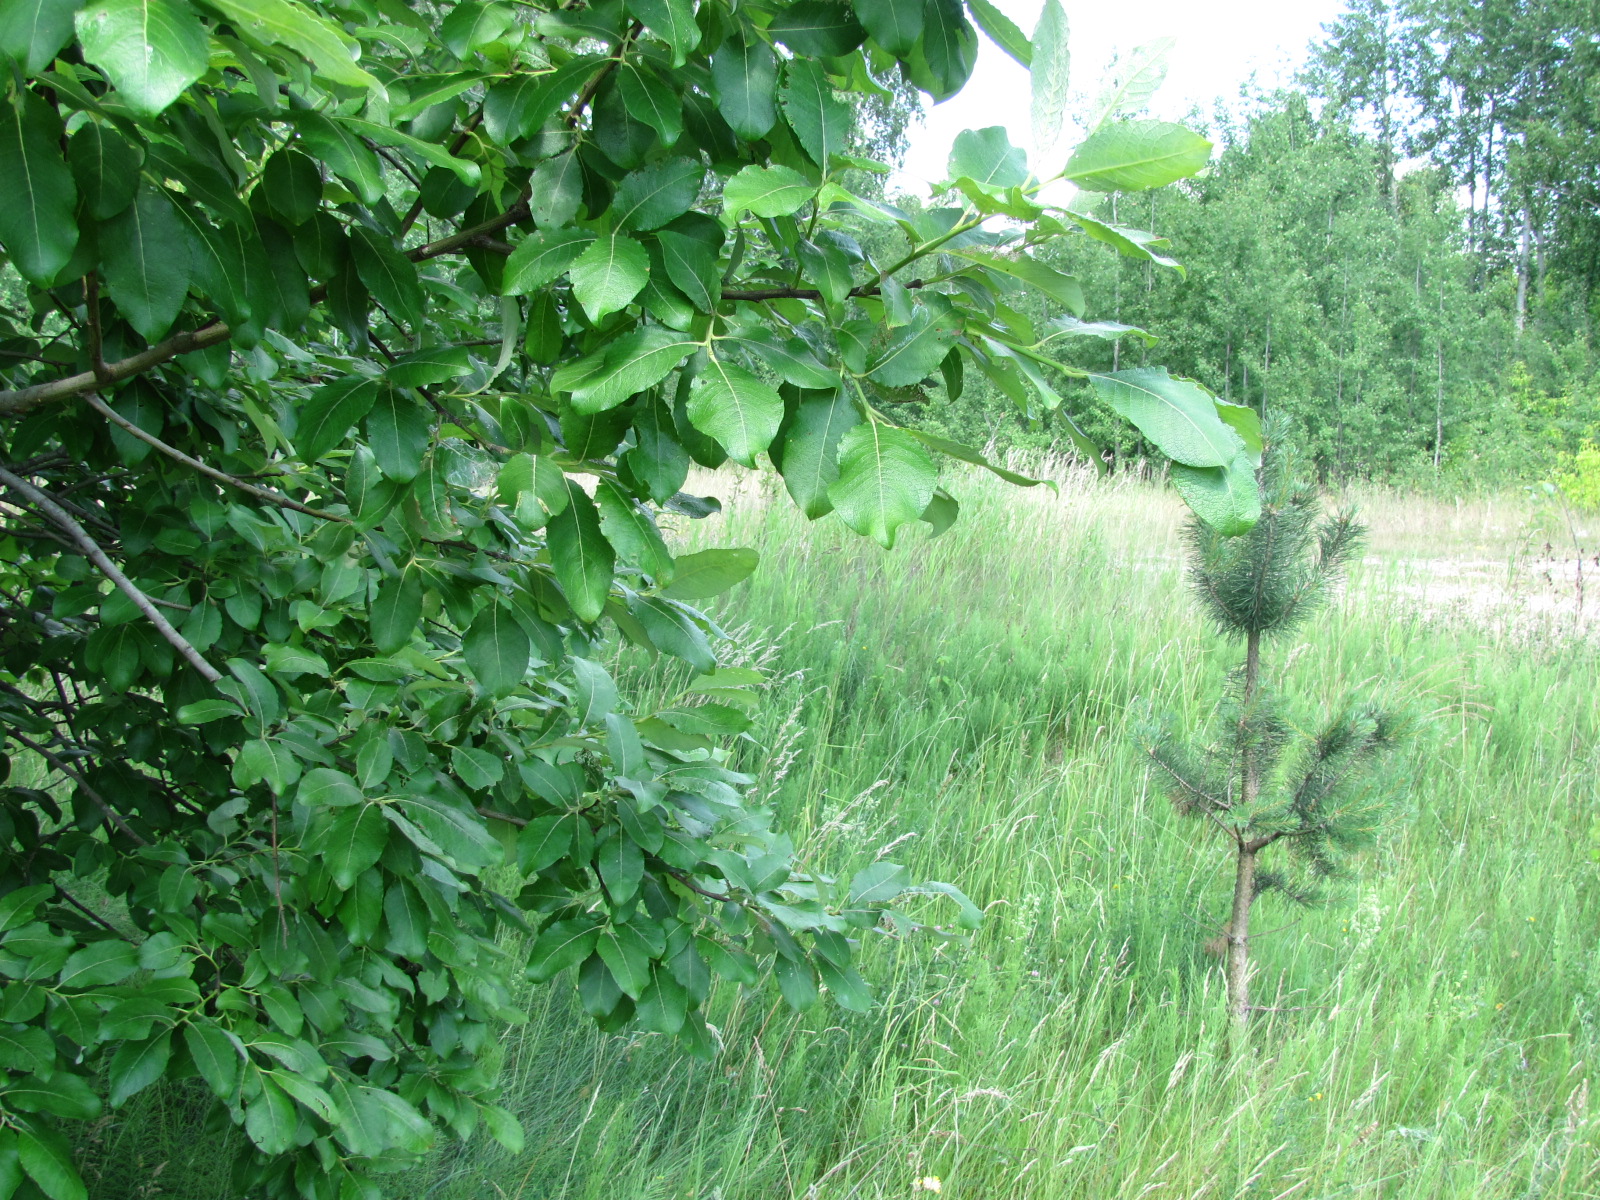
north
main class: Woodland
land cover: Broadleaved woodland
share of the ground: 50 - 75 %
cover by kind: broadleaved forest trees 60 %, herbaceous plants 40 %
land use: Amenities, museums, leisure
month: July
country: LV
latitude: 56.8903
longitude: 24.2208
